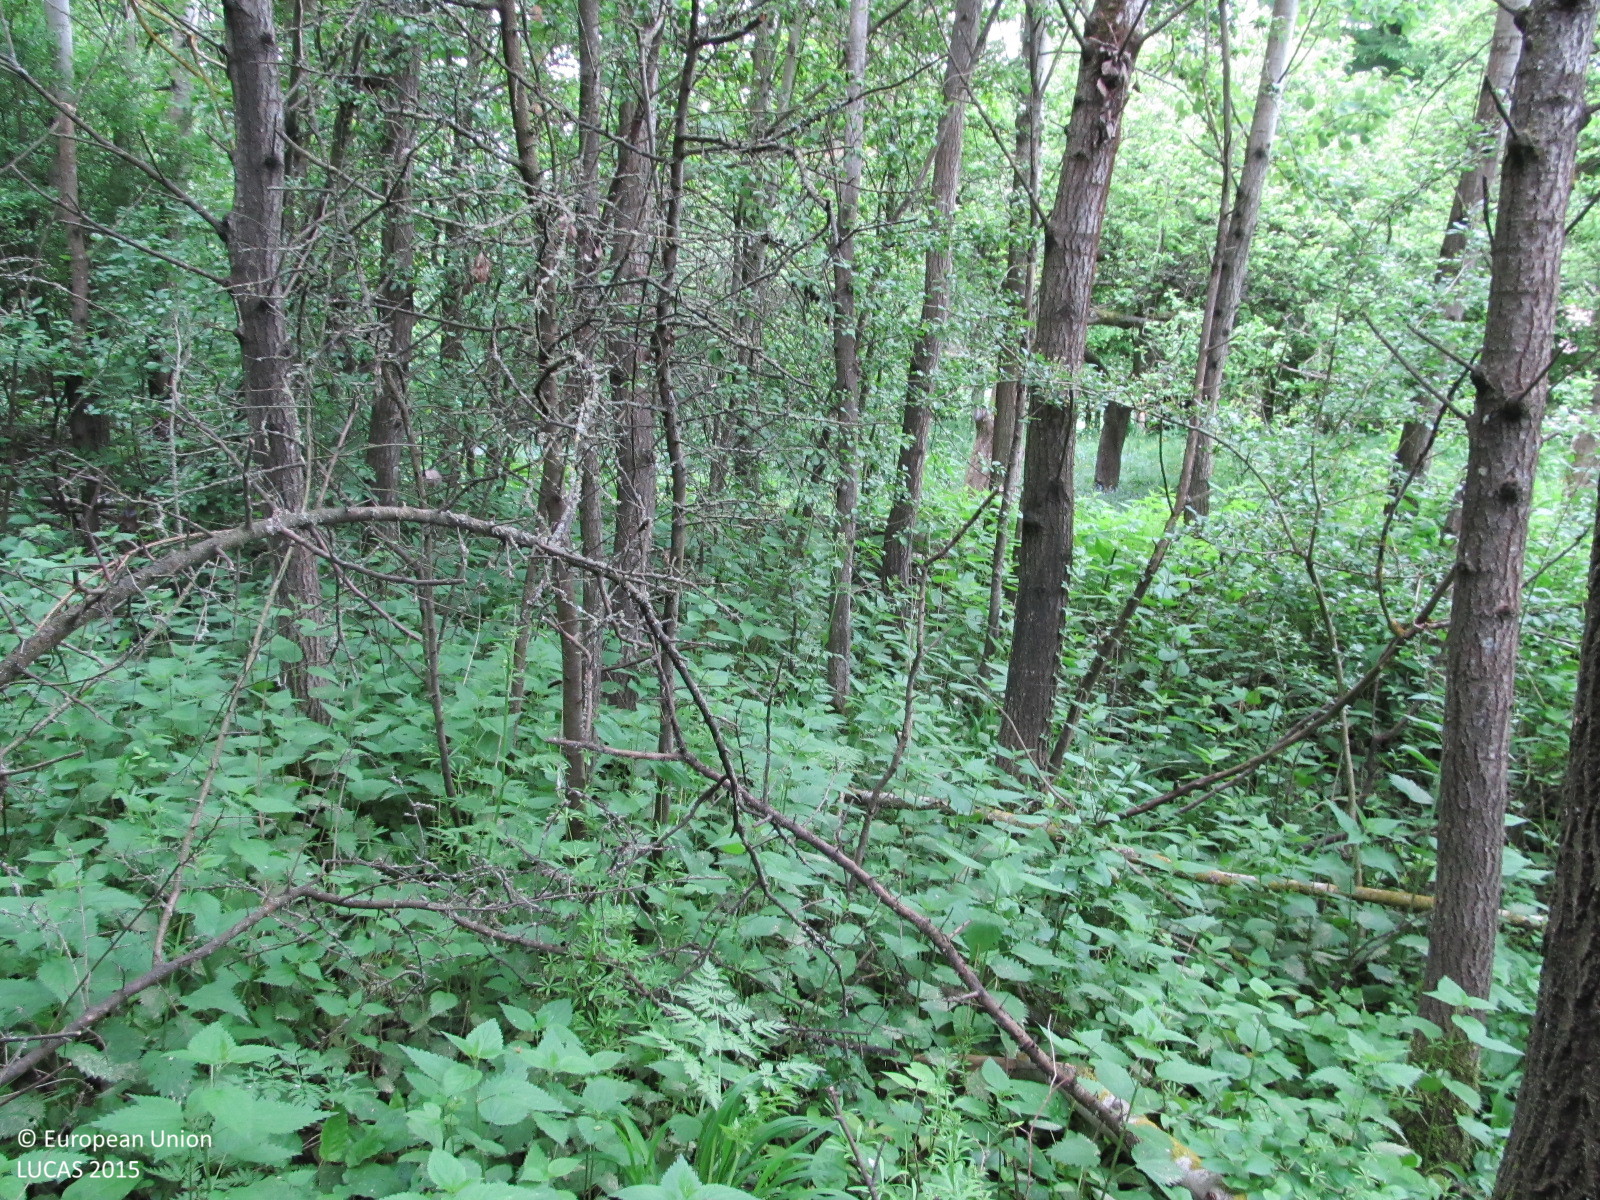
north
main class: Woodland
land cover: Spruce dominated mixed woodland
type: mesophytic deciduous forest
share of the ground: 50 - 75 %
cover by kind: coniferous forest trees 60 %, broadleaved forest trees 30 %, shrubs 10 %
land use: Forestry
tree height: > 5 m
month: May
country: AT
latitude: 48.6633
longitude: 15.5018
